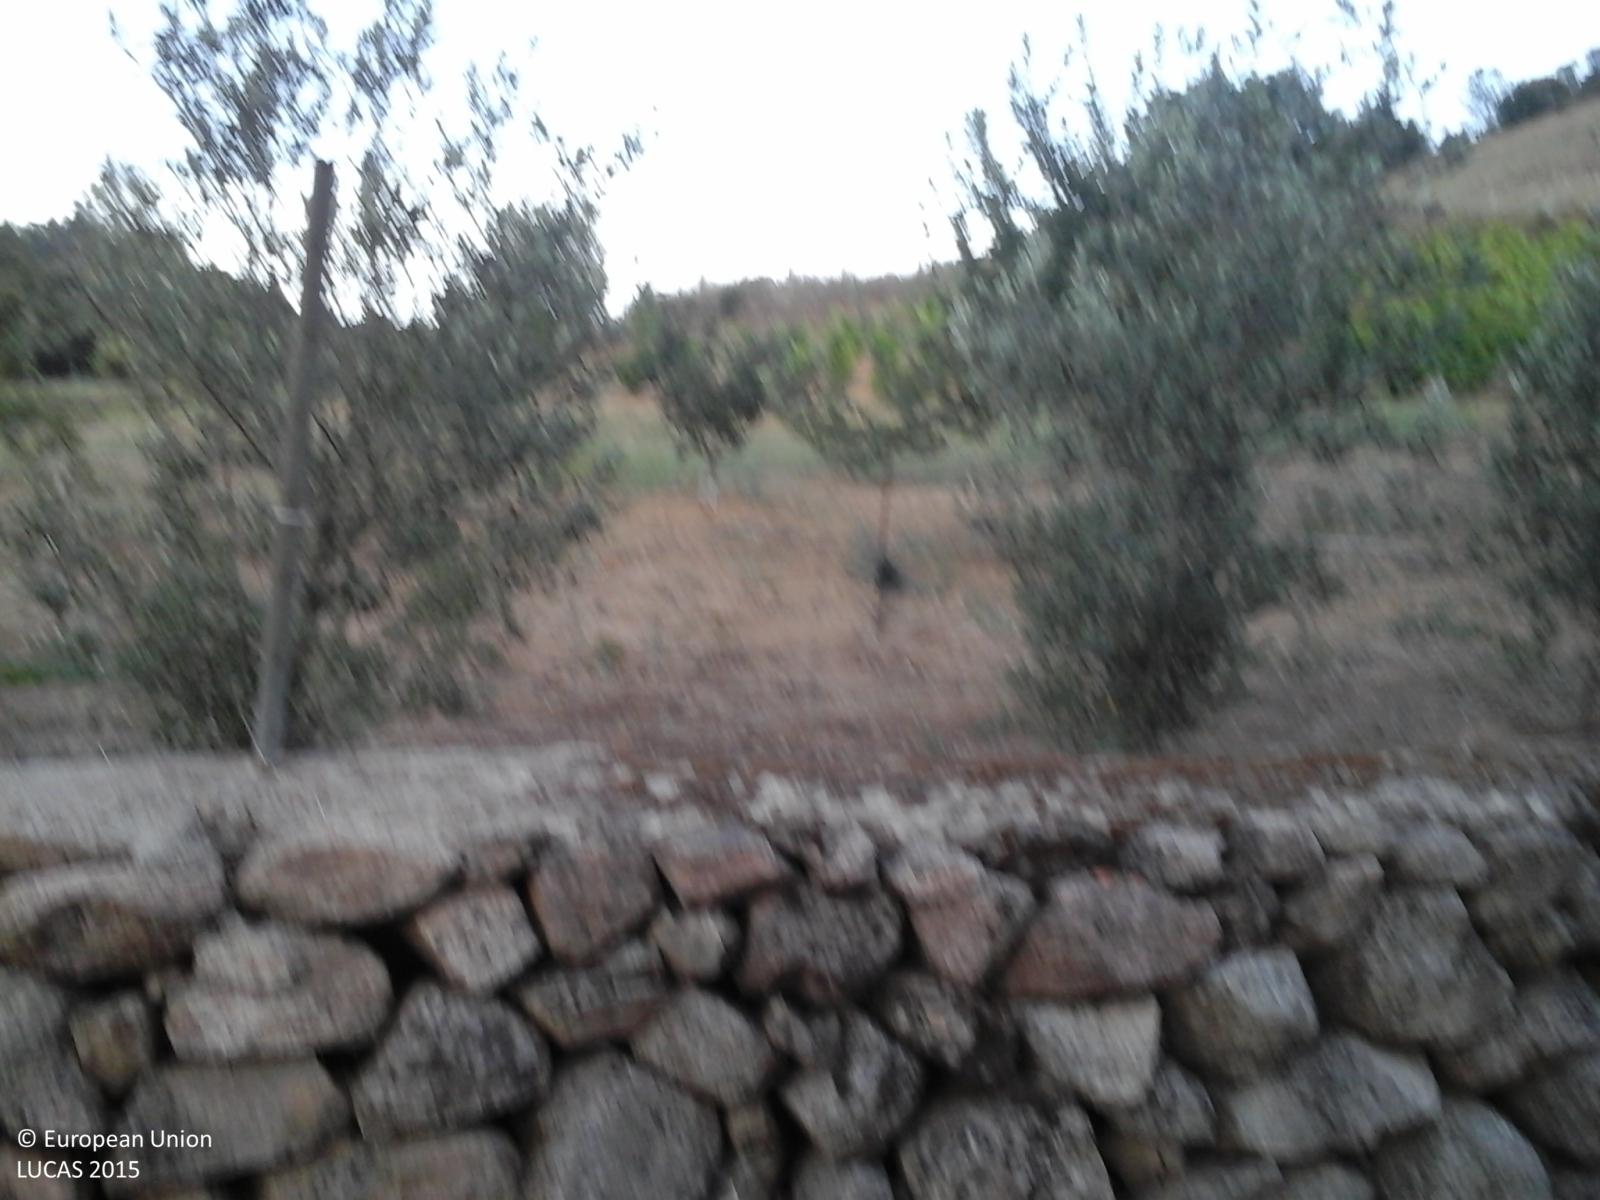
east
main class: Cropland
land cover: Vineyards
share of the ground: > 75 %
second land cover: Spontaneously vegetated surfaces
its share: 50 - 75 %
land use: Agriculture (excluding fallow land and kitchen gardens)
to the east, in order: Vineyards; Spontaneously vegetated surfaces; Grassland with sparse tree/shrub cover; Fences; Grassland without tree/shrub cover; Abandoned hedges; Temporary grasslands; Abandoned hedges; Dry stone walls; Grassland without tree/shrub cover
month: August
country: IT
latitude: 39.9724
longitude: 8.9869
